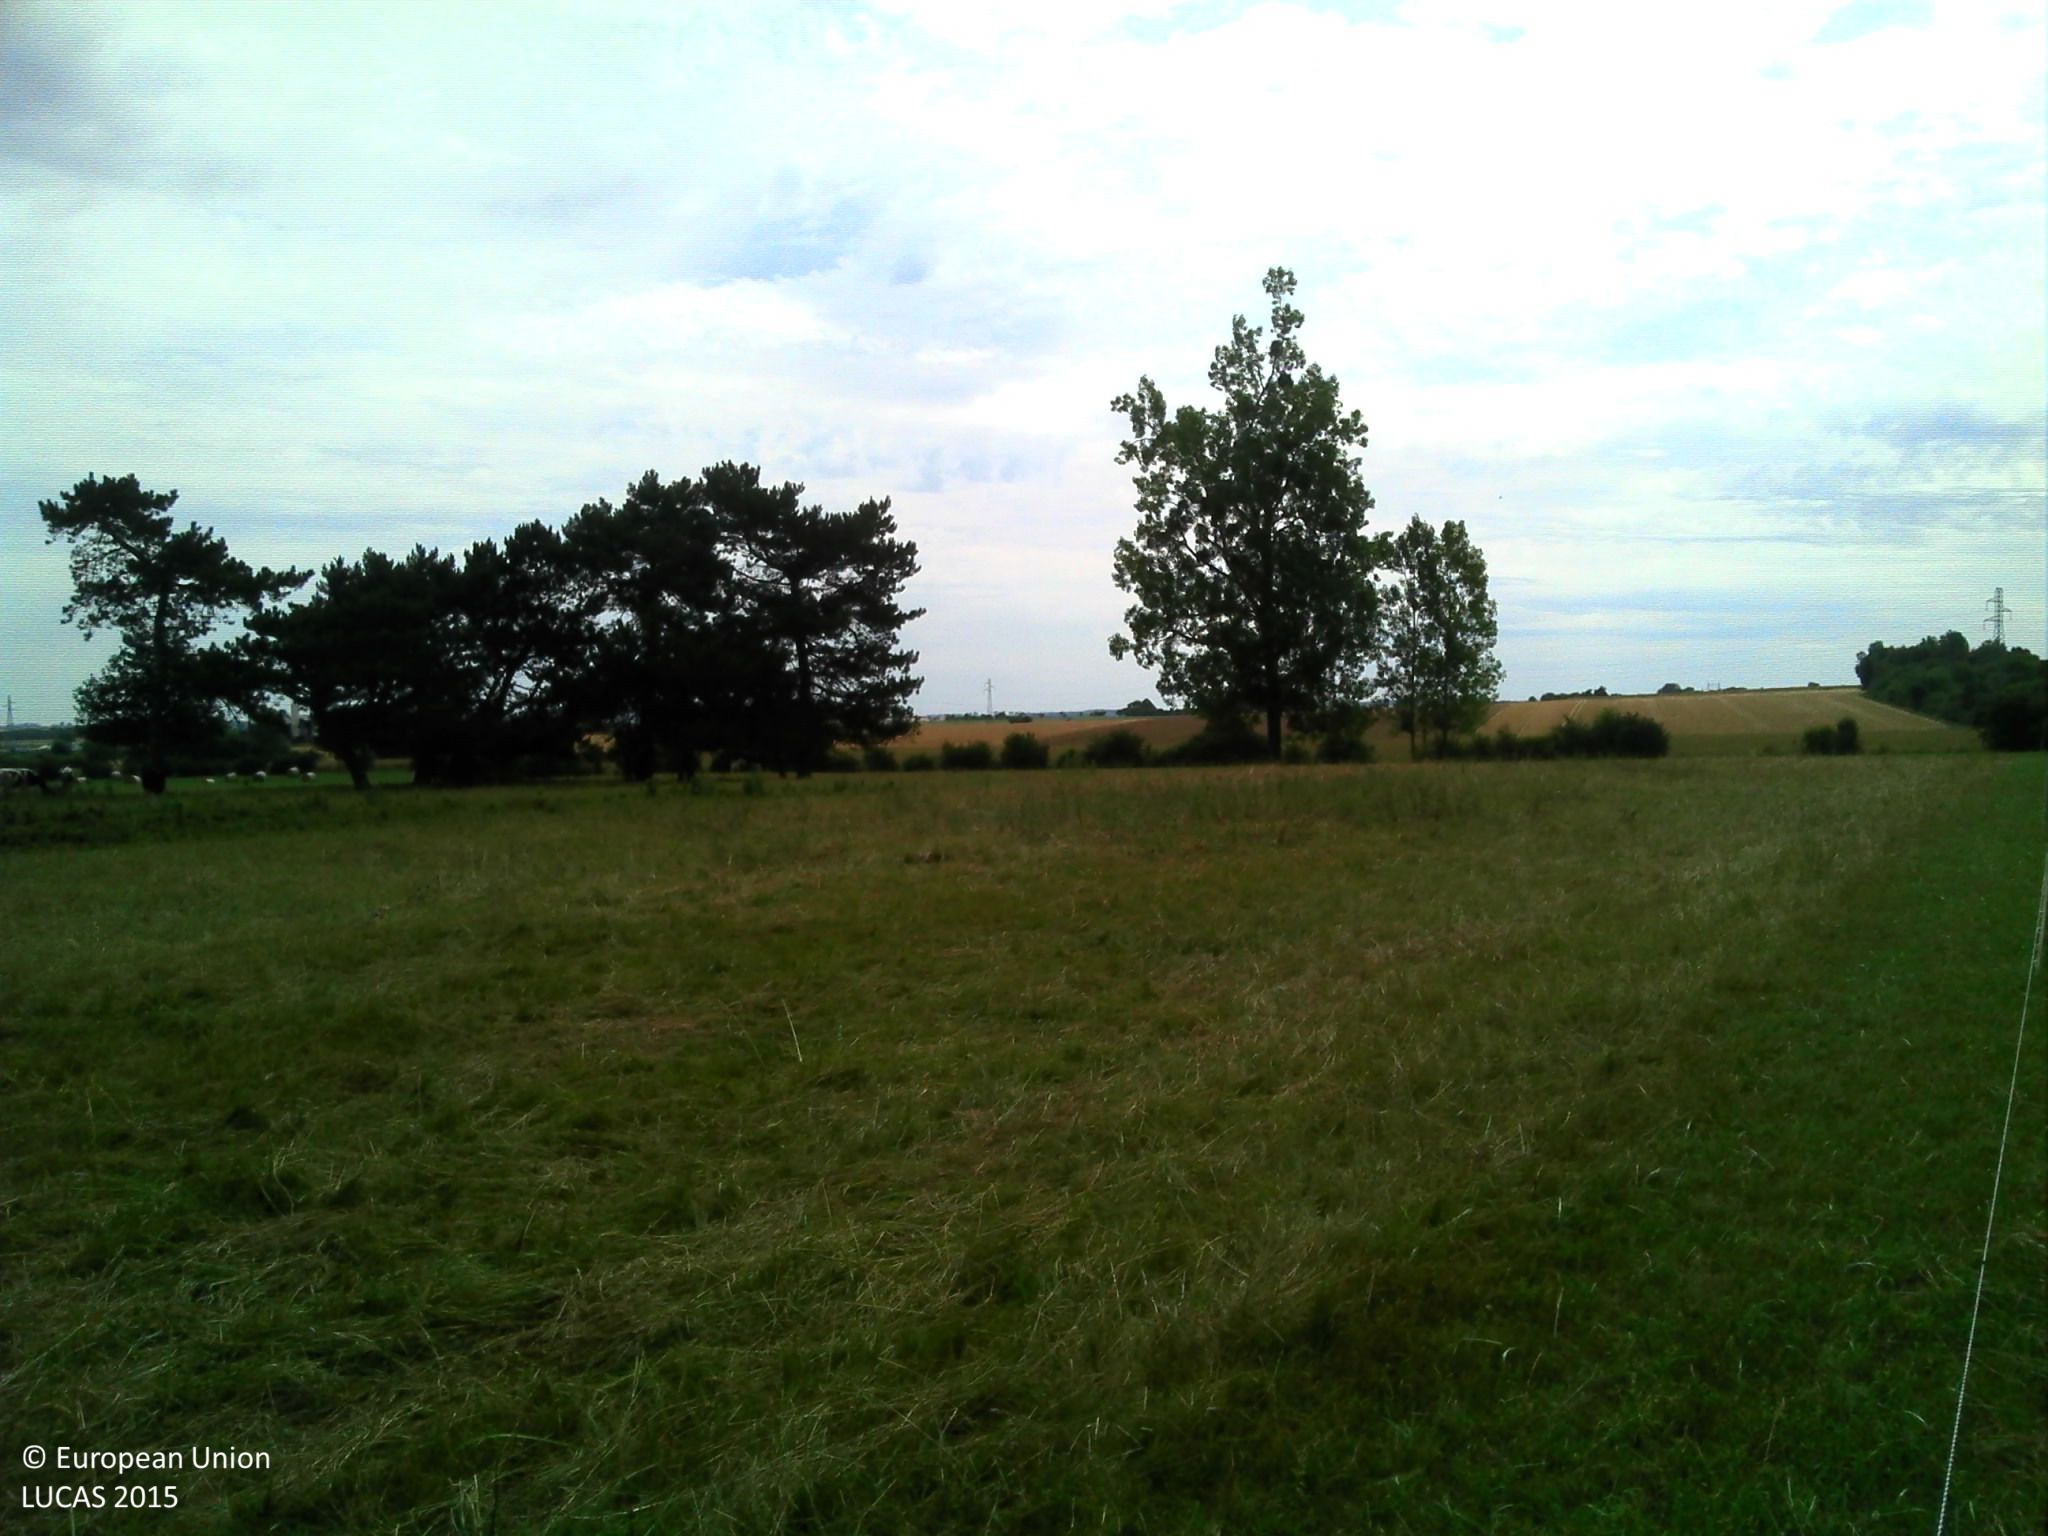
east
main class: Grassland
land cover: Grassland without tree/shrub cover
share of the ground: > 75 %
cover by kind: herbaceous plants 100 %
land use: Agriculture (excluding fallow land and kitchen gardens)
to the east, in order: Grassland without tree/shrub cover; Pine dominated coniferous woodland; Grassland without tree/shrub cover; Fences; Grassland without tree/shrub cover; Shruby margins; Fences; Rape and turnip rape
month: June
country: FR
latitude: 48.4795
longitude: 6.1175
